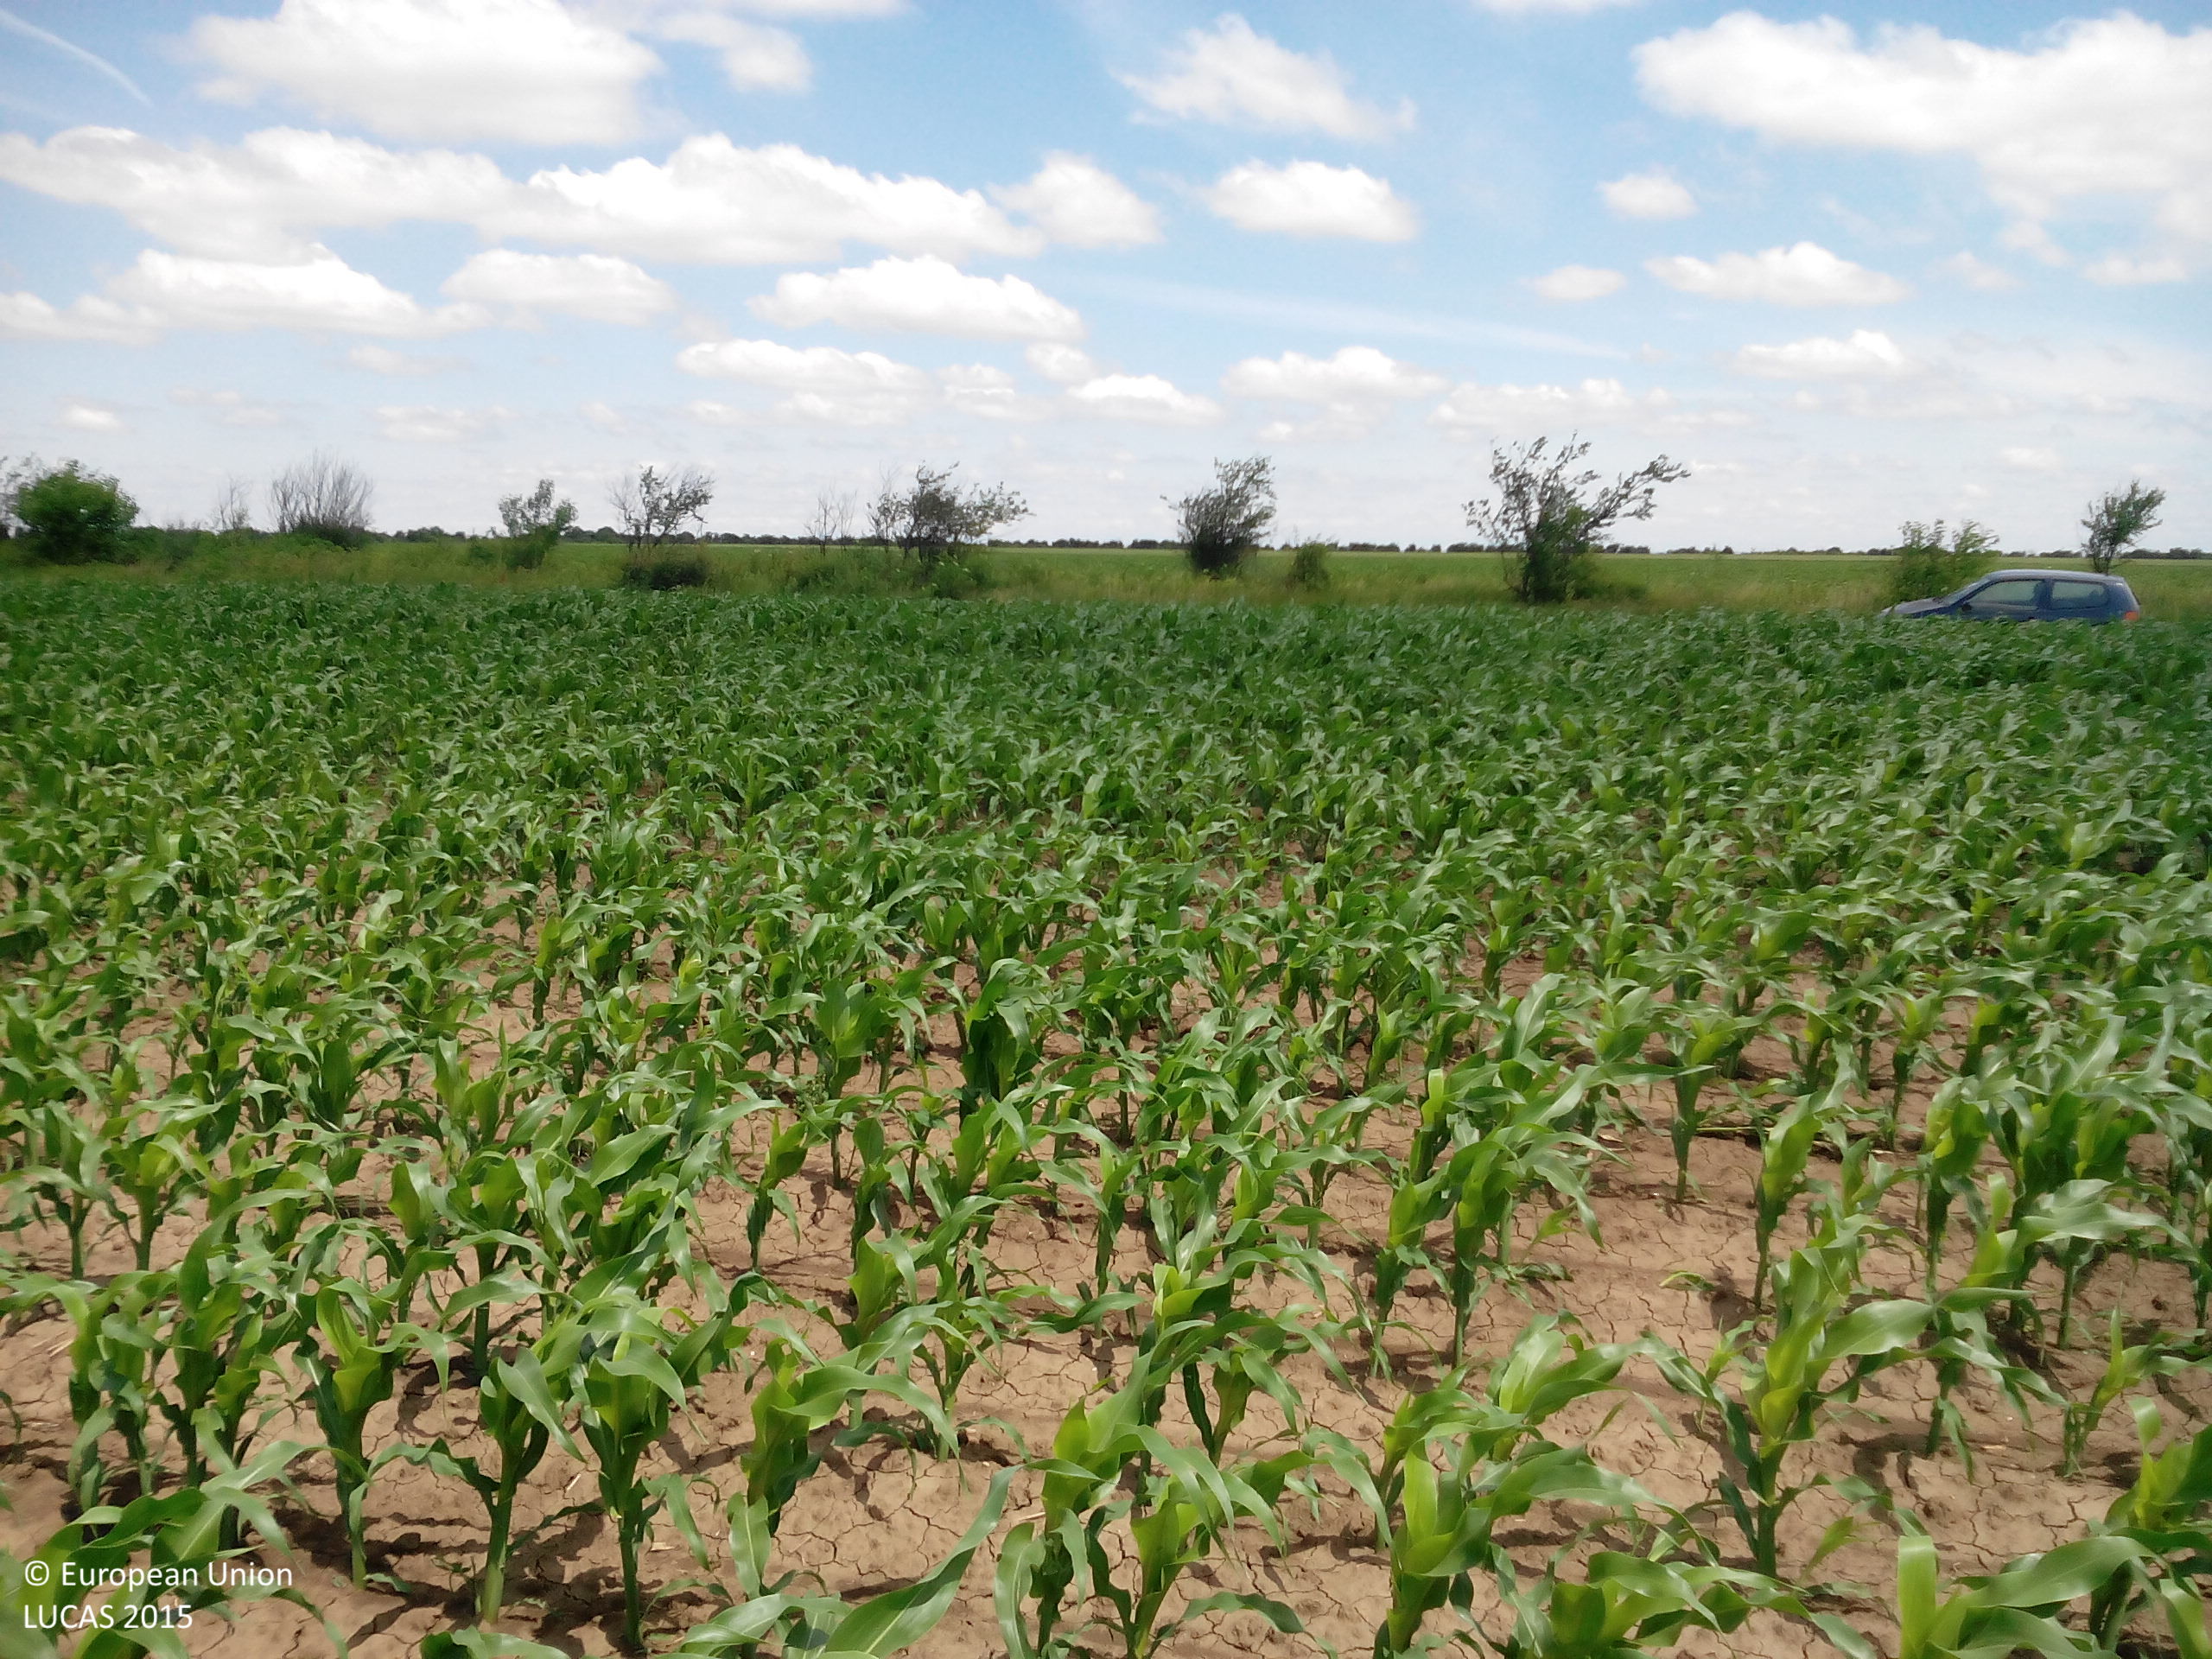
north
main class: Cropland
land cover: Maize
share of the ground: 50 - 75 %
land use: Agriculture (excluding fallow land and kitchen gardens)
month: May
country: BG
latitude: 43.4900
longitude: 24.1141
